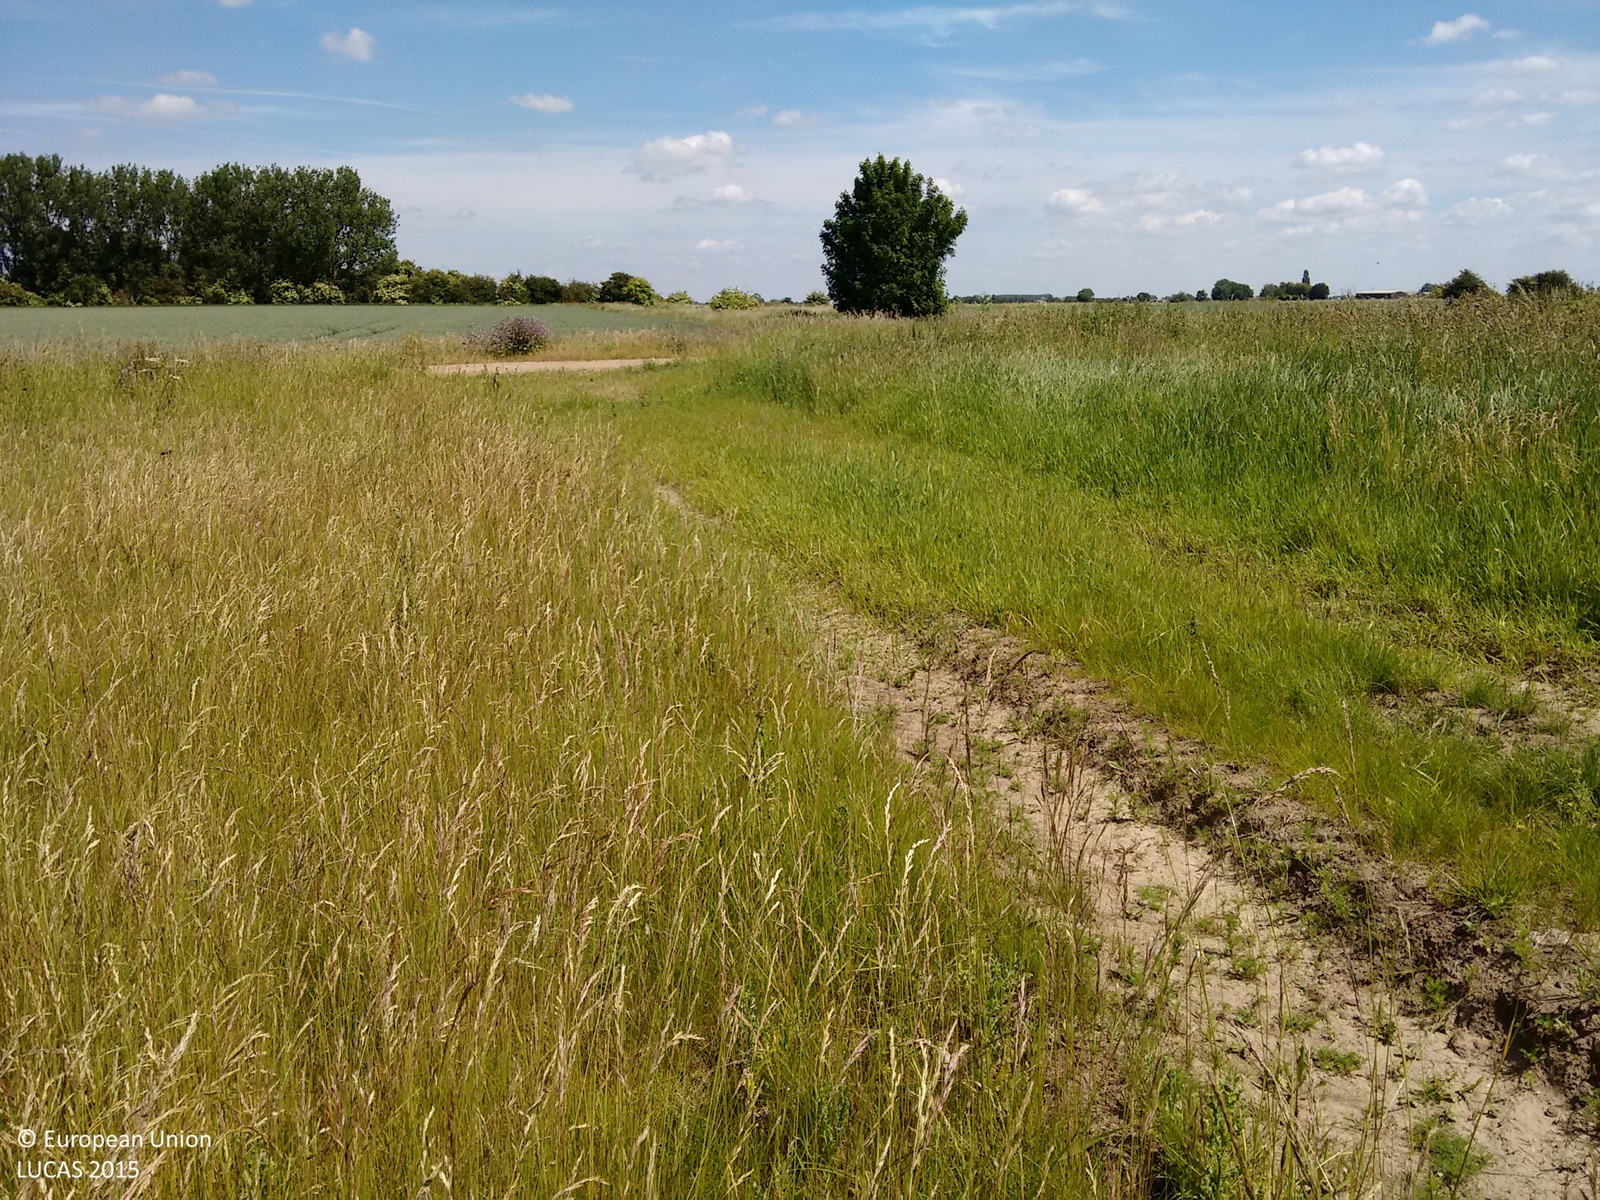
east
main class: Grassland
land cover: Spontaneously vegetated surfaces
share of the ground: > 75 %
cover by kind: herbaceous plants 100 %
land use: Energy production
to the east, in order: Spontaneously vegetated surfaces; Tracks; Spontaneously vegetated surfaces; Tracks; Grass margins; Common wheat
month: June
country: GB
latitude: 52.5832
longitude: 0.1546
